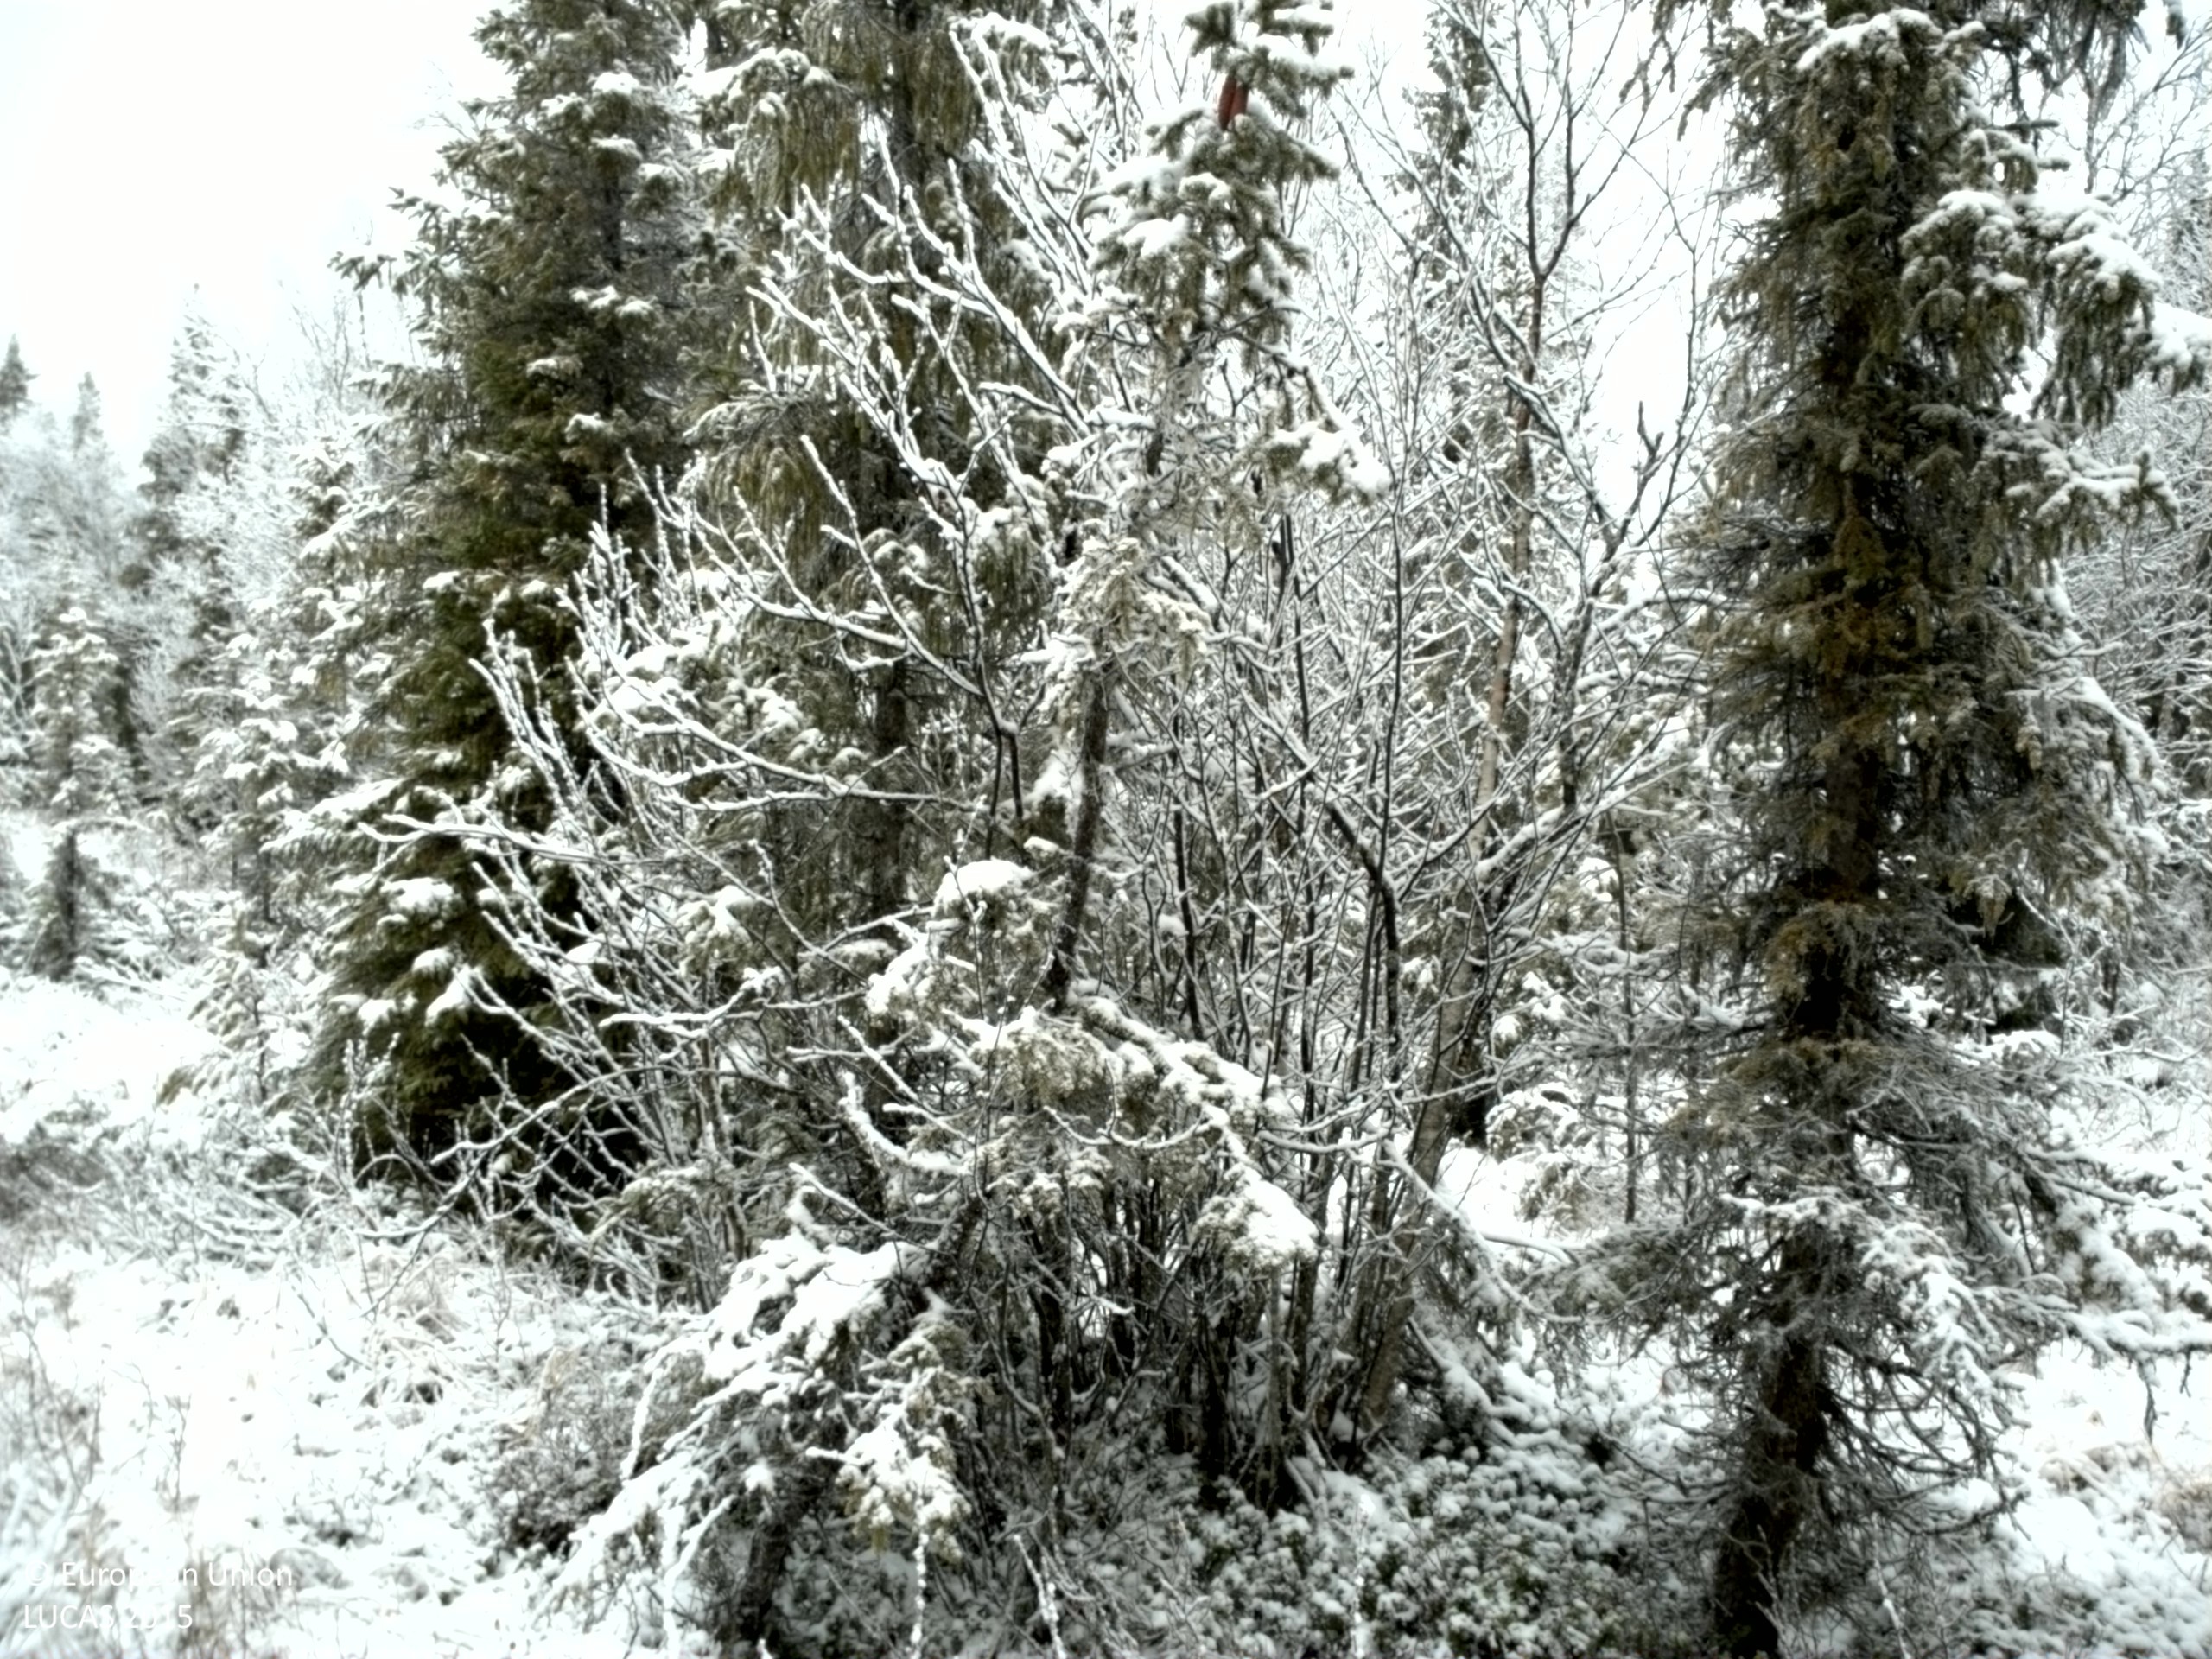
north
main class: Woodland
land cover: Spruce dominated mixed woodland
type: exotic forest
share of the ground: 50 - 75 %
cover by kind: shrubs 35 %, coniferous forest trees 30 %, broadleaved forest trees 20 %, lichens and mosses 15 %
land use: Forestry
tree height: > 5 m
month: November
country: SE
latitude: 63.7292
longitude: 15.3407
